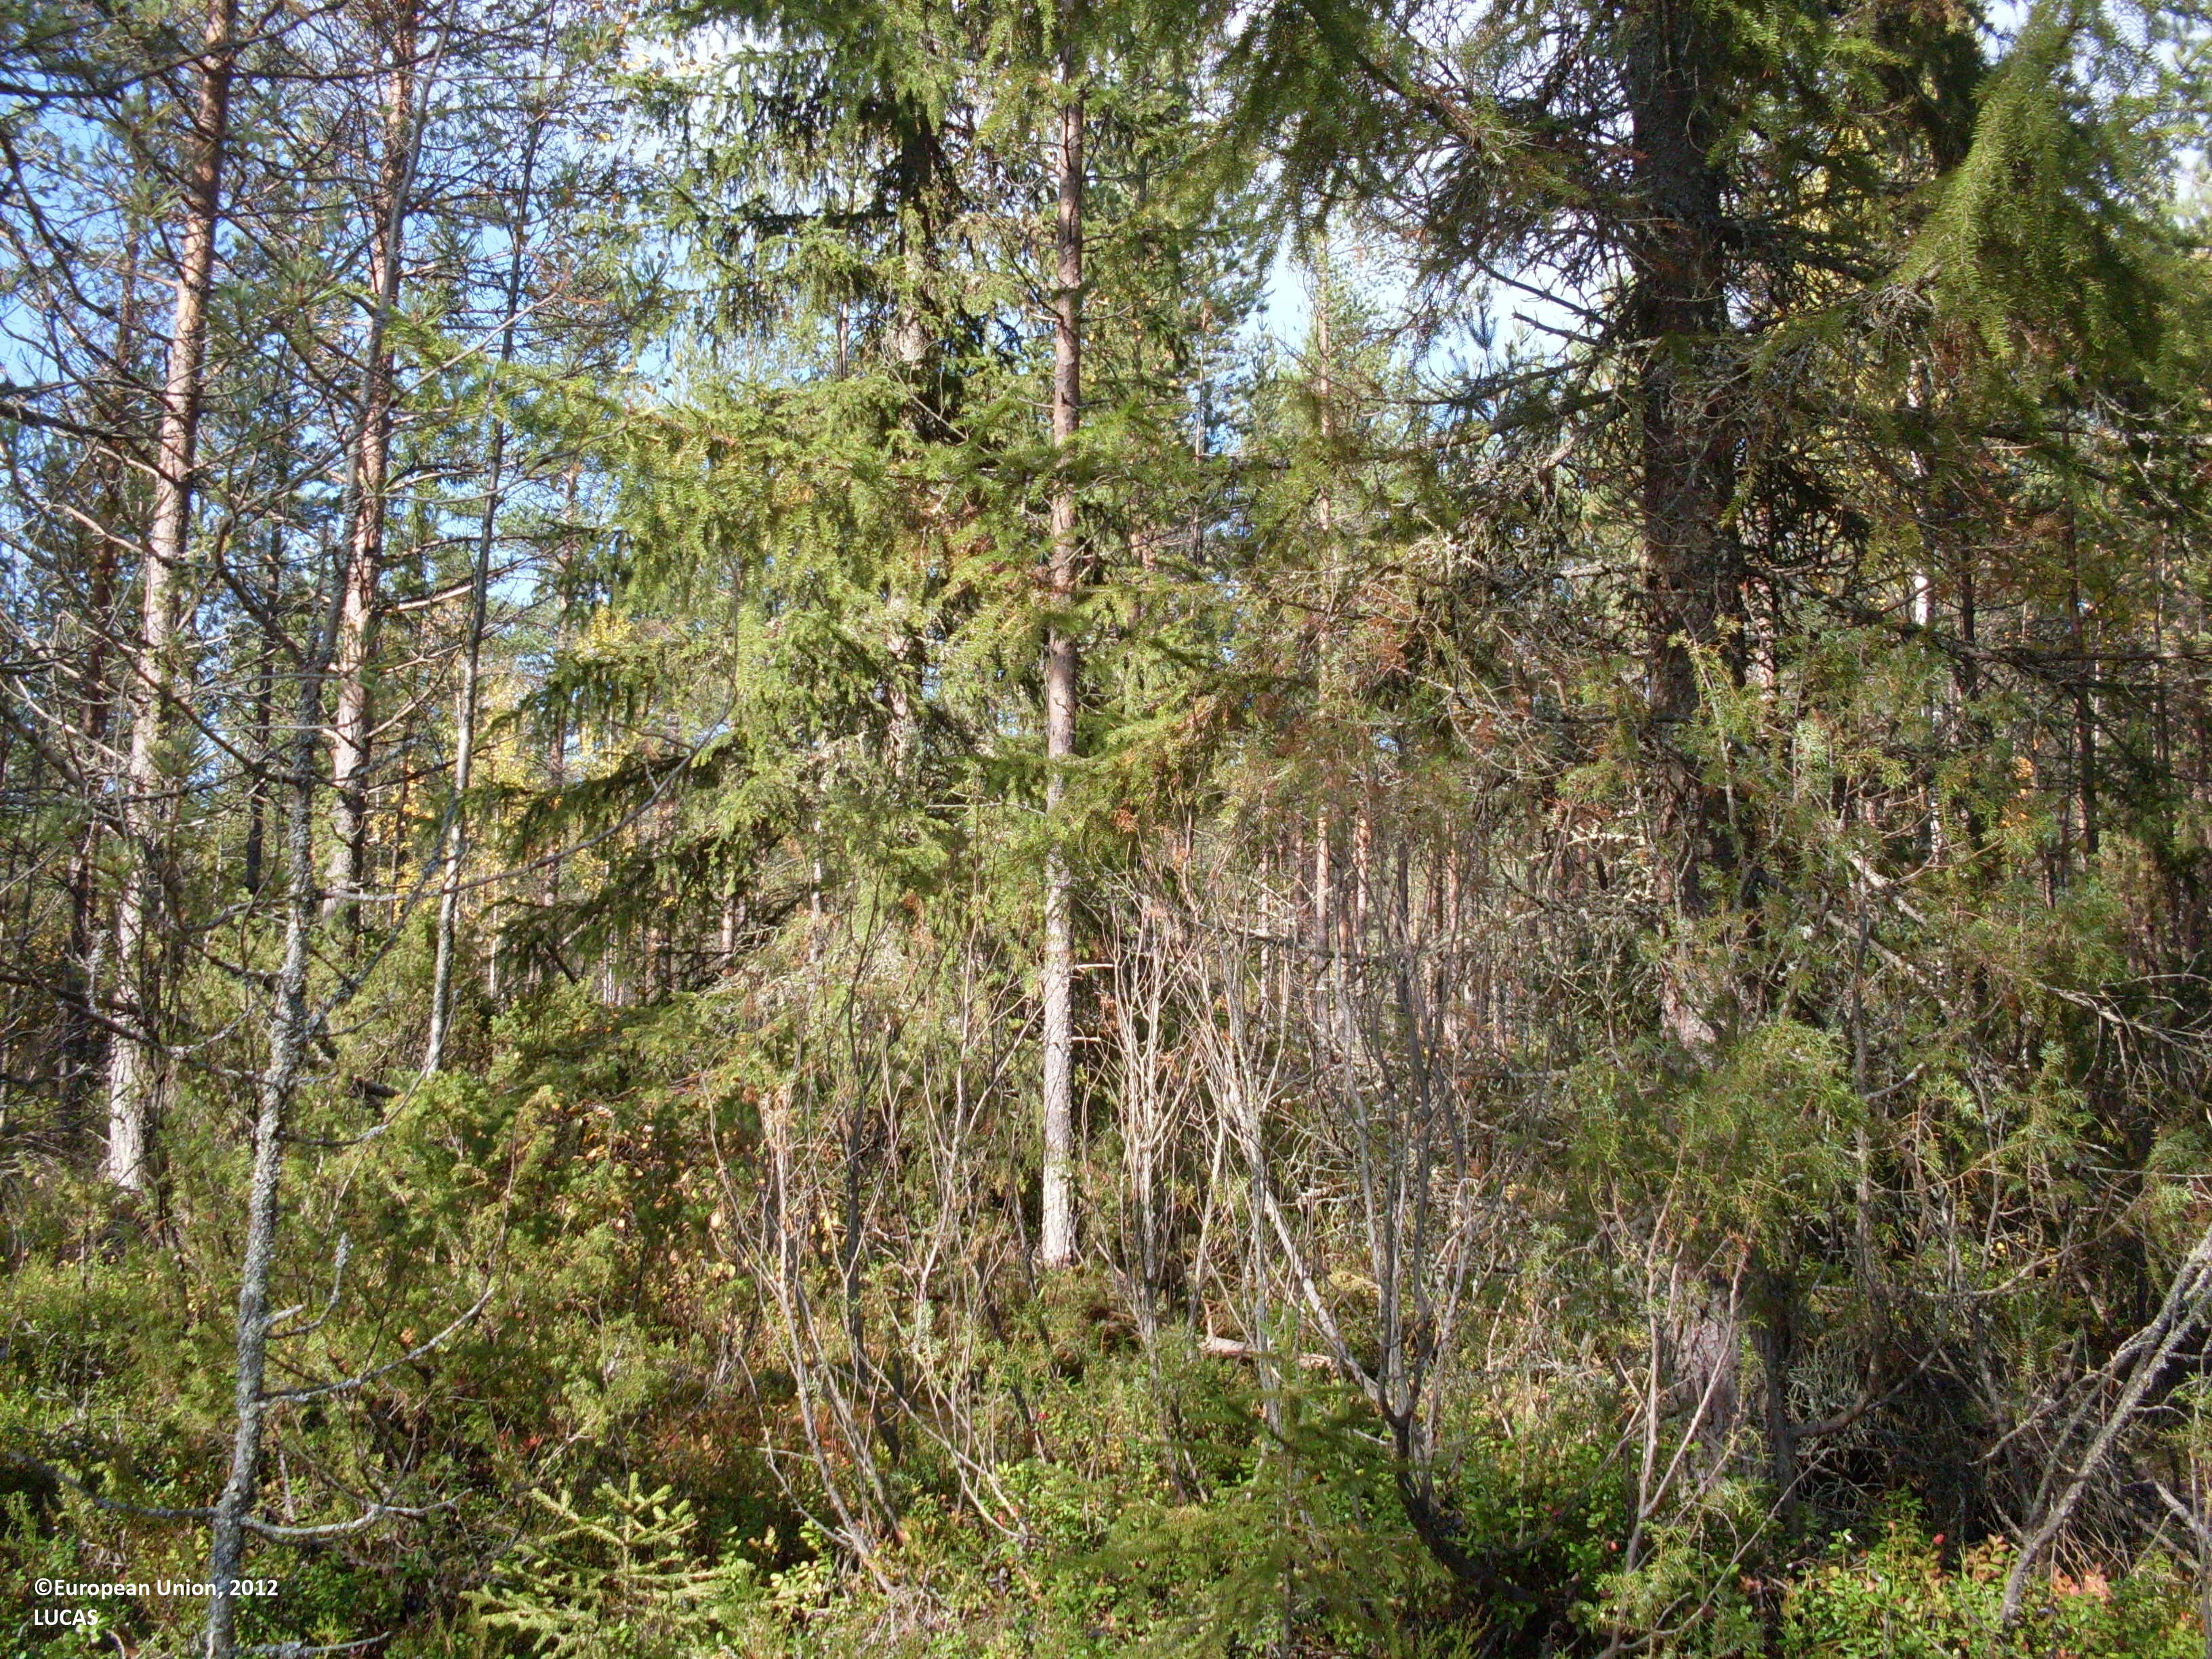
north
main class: Woodland
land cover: Pine dominated mixed woodland
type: boreal forest
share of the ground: > 75 %
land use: Forestry
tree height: > 5 m
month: September
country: FI
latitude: 64.3656
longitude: 28.5986
